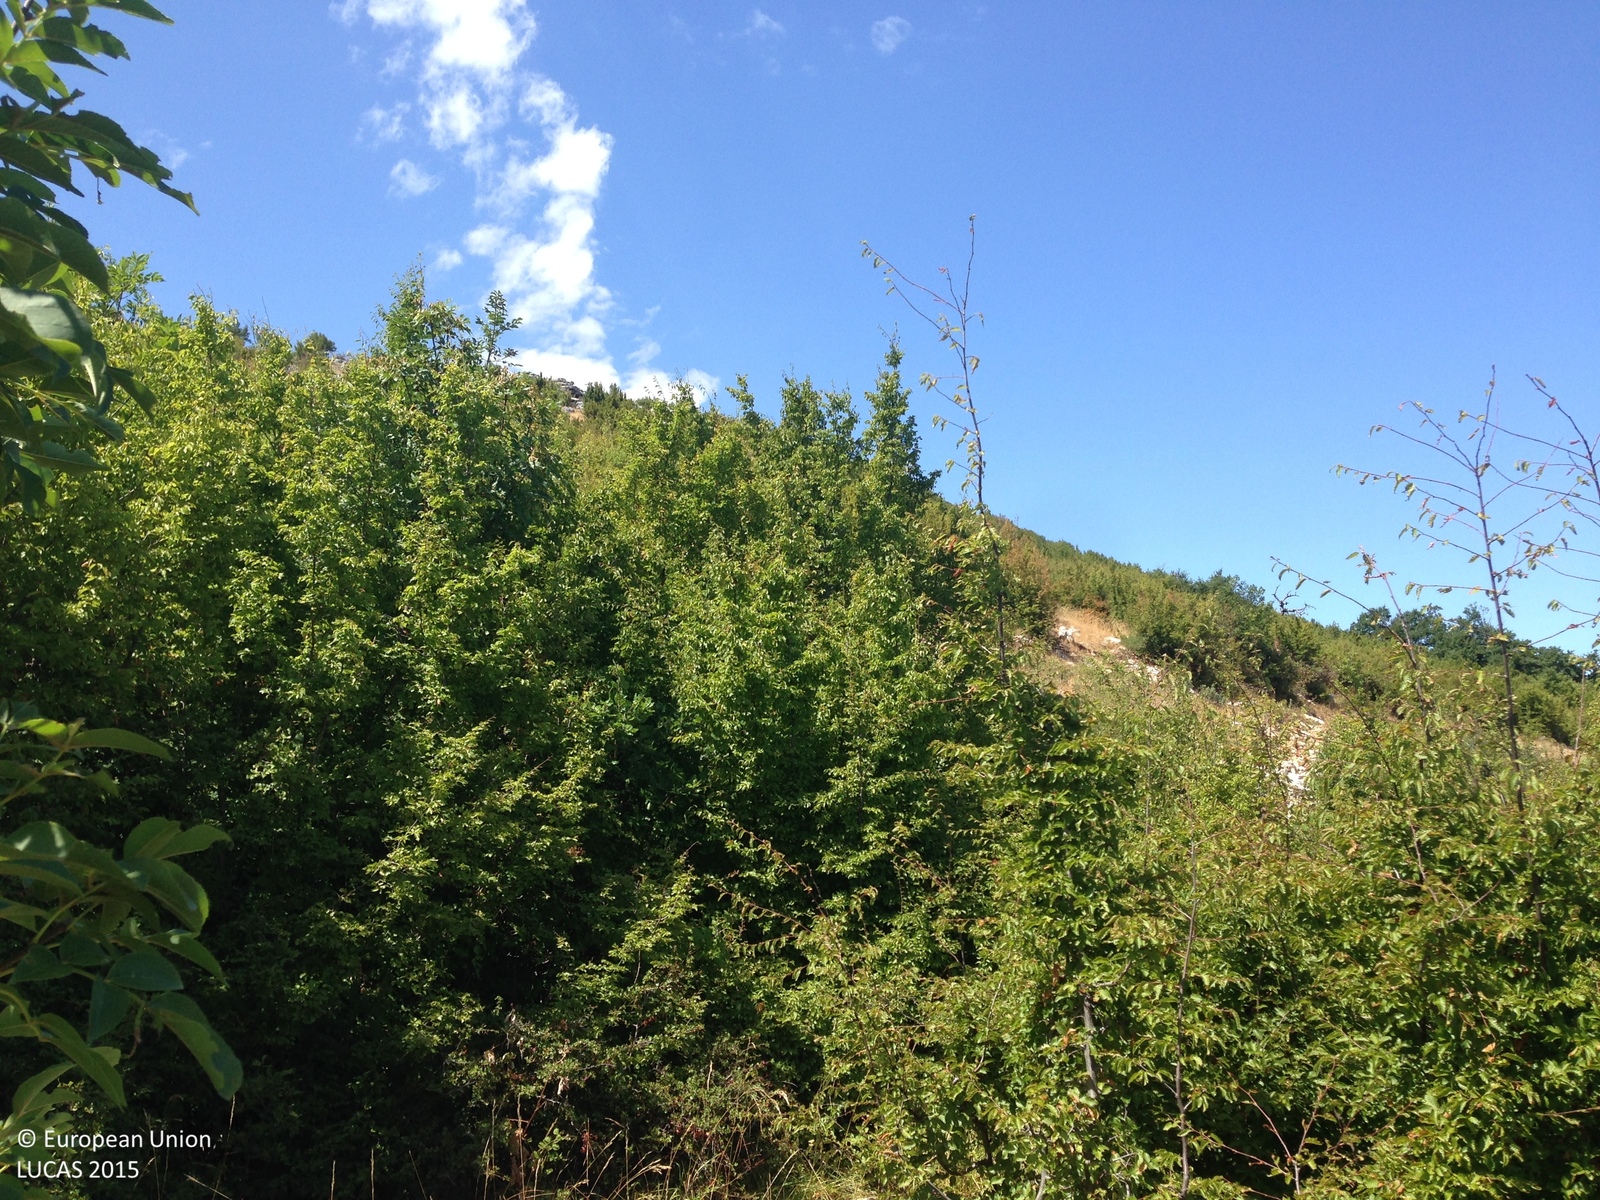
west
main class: Woodland
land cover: Broadleaved woodland
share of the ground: > 75 %
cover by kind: broadleaved forest trees 50 %, herbaceous plants 15 %, consolidated bare surface 15 %, shrubs 10 %, unconsolidated bare surface 10 %
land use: Semi-natural and natural areas not in use
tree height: < 5 m
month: July
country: HR
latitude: 44.1380
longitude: 15.7298
